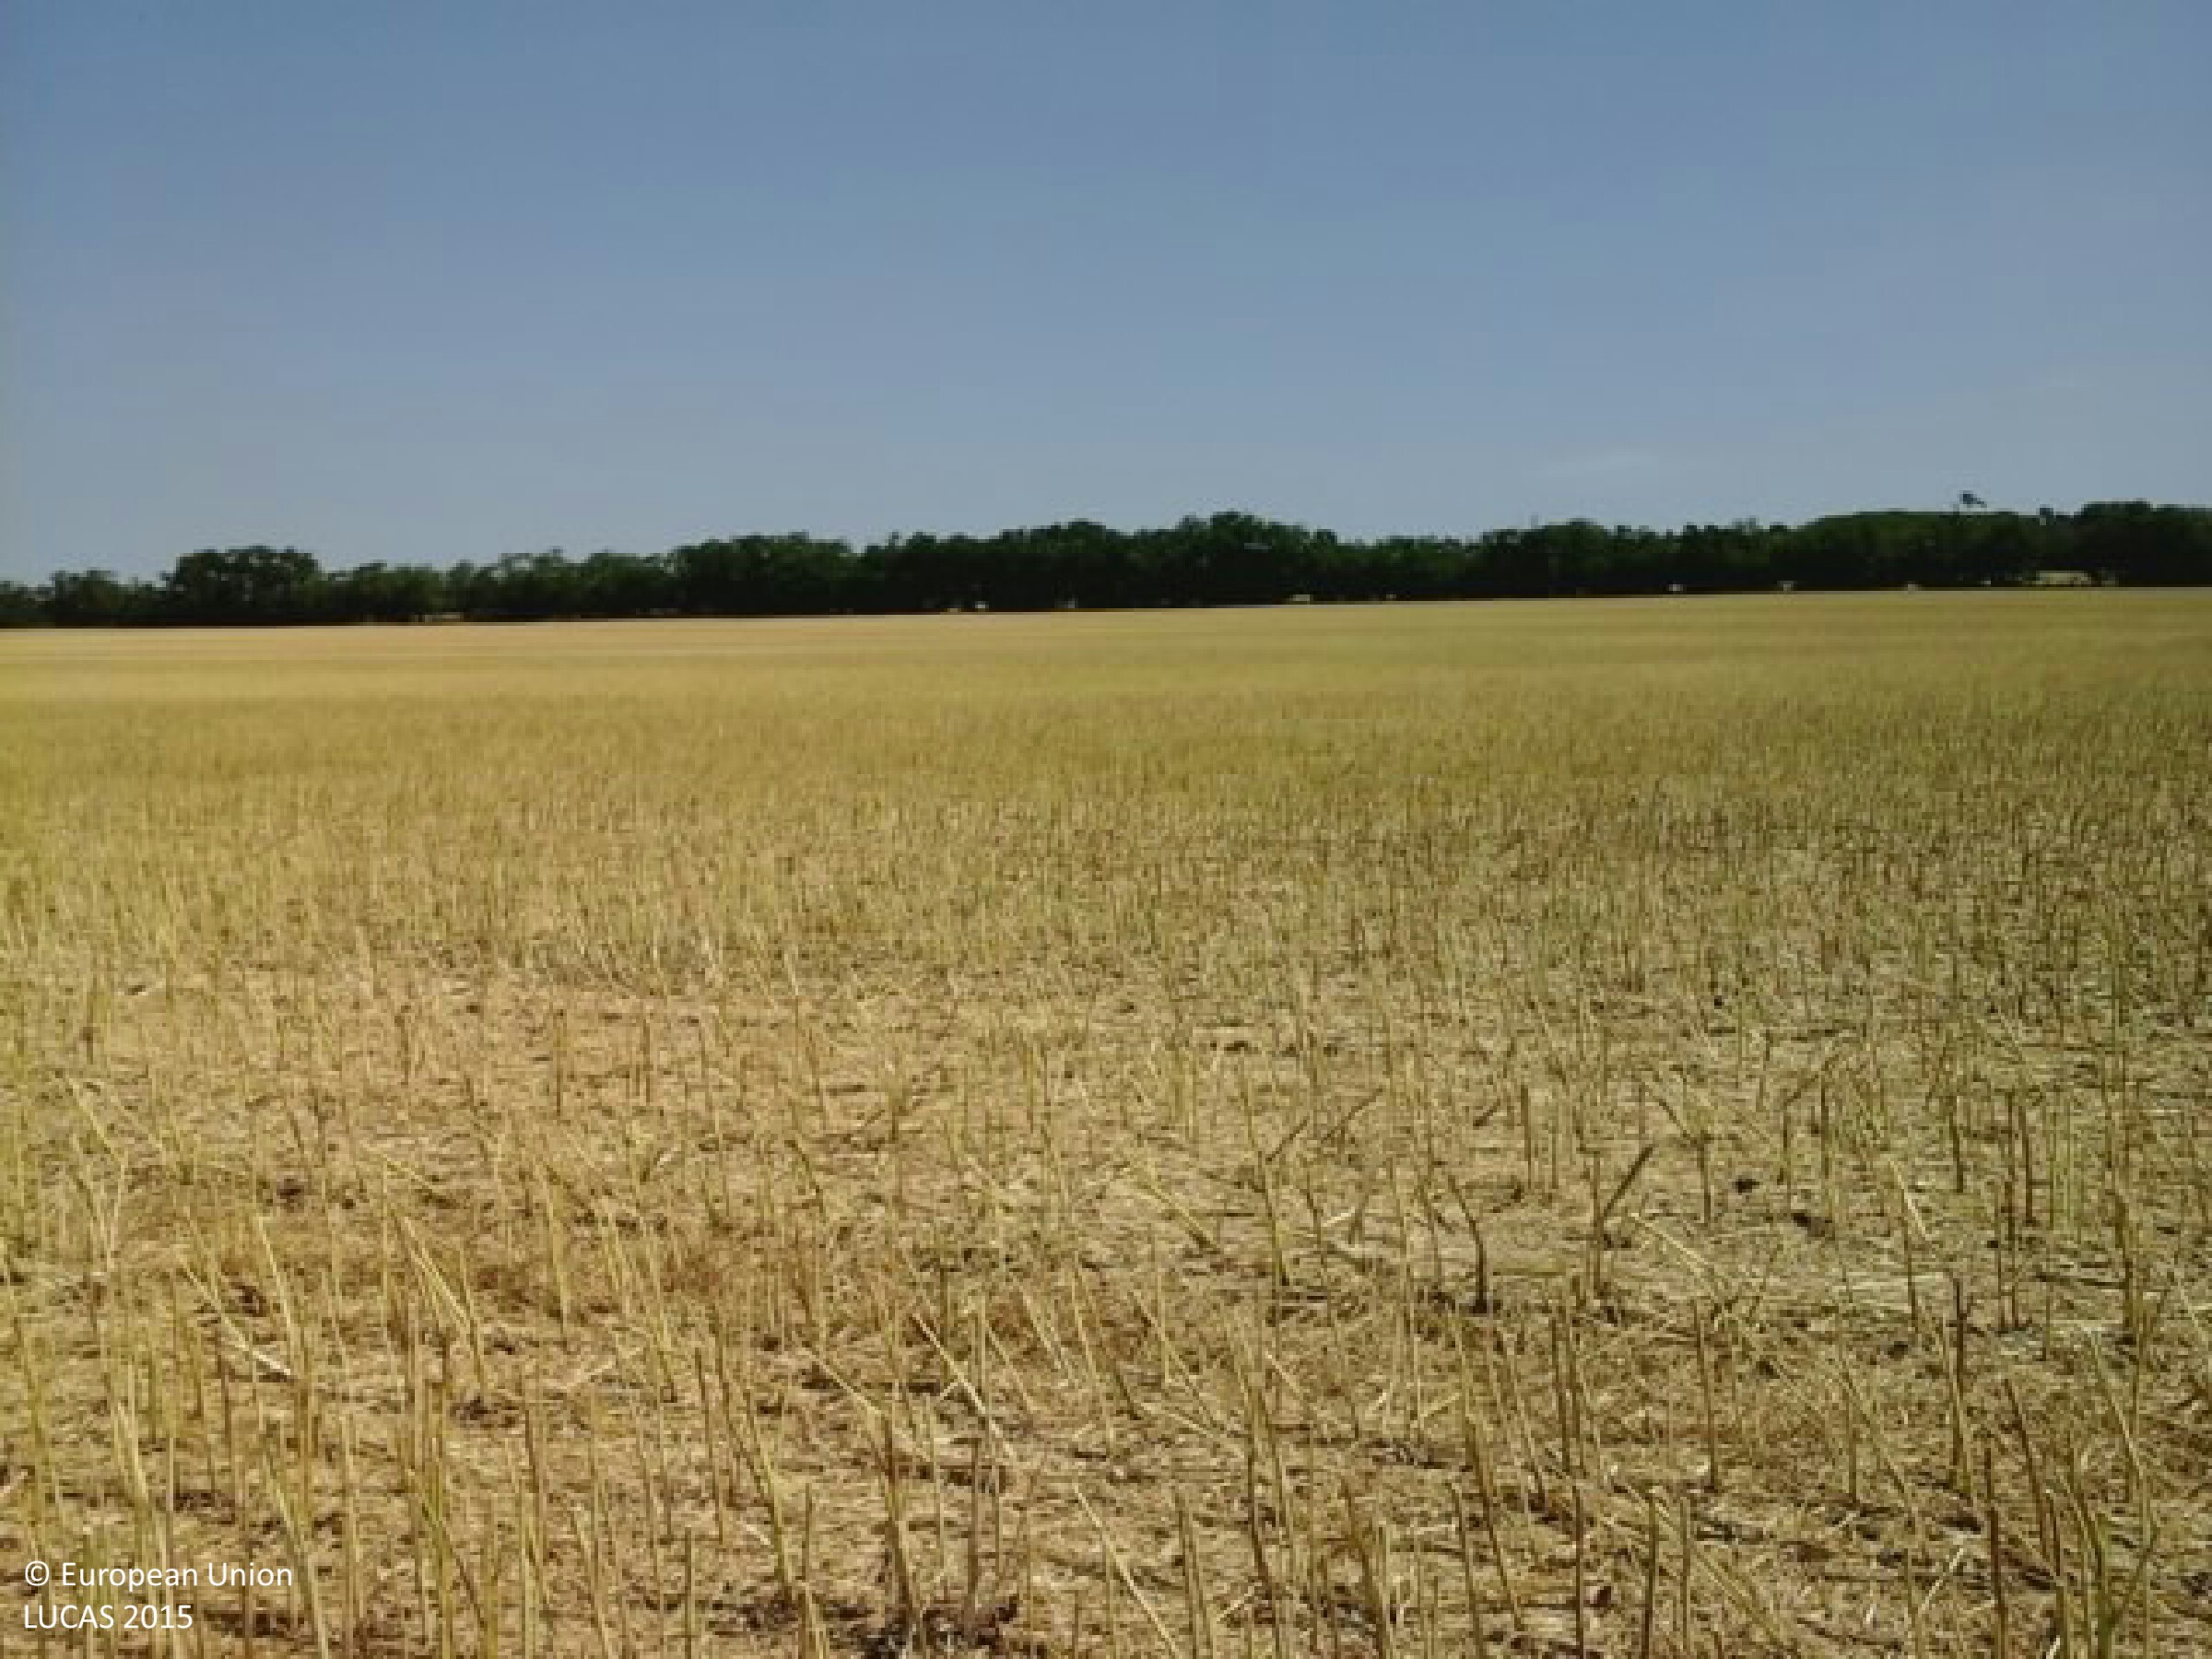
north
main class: Cropland
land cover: Rape and turnip rape
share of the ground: > 75 %
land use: Agriculture (excluding fallow land and kitchen gardens)
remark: Harvested field
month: June
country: HU
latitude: 47.4501
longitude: 19.2901
